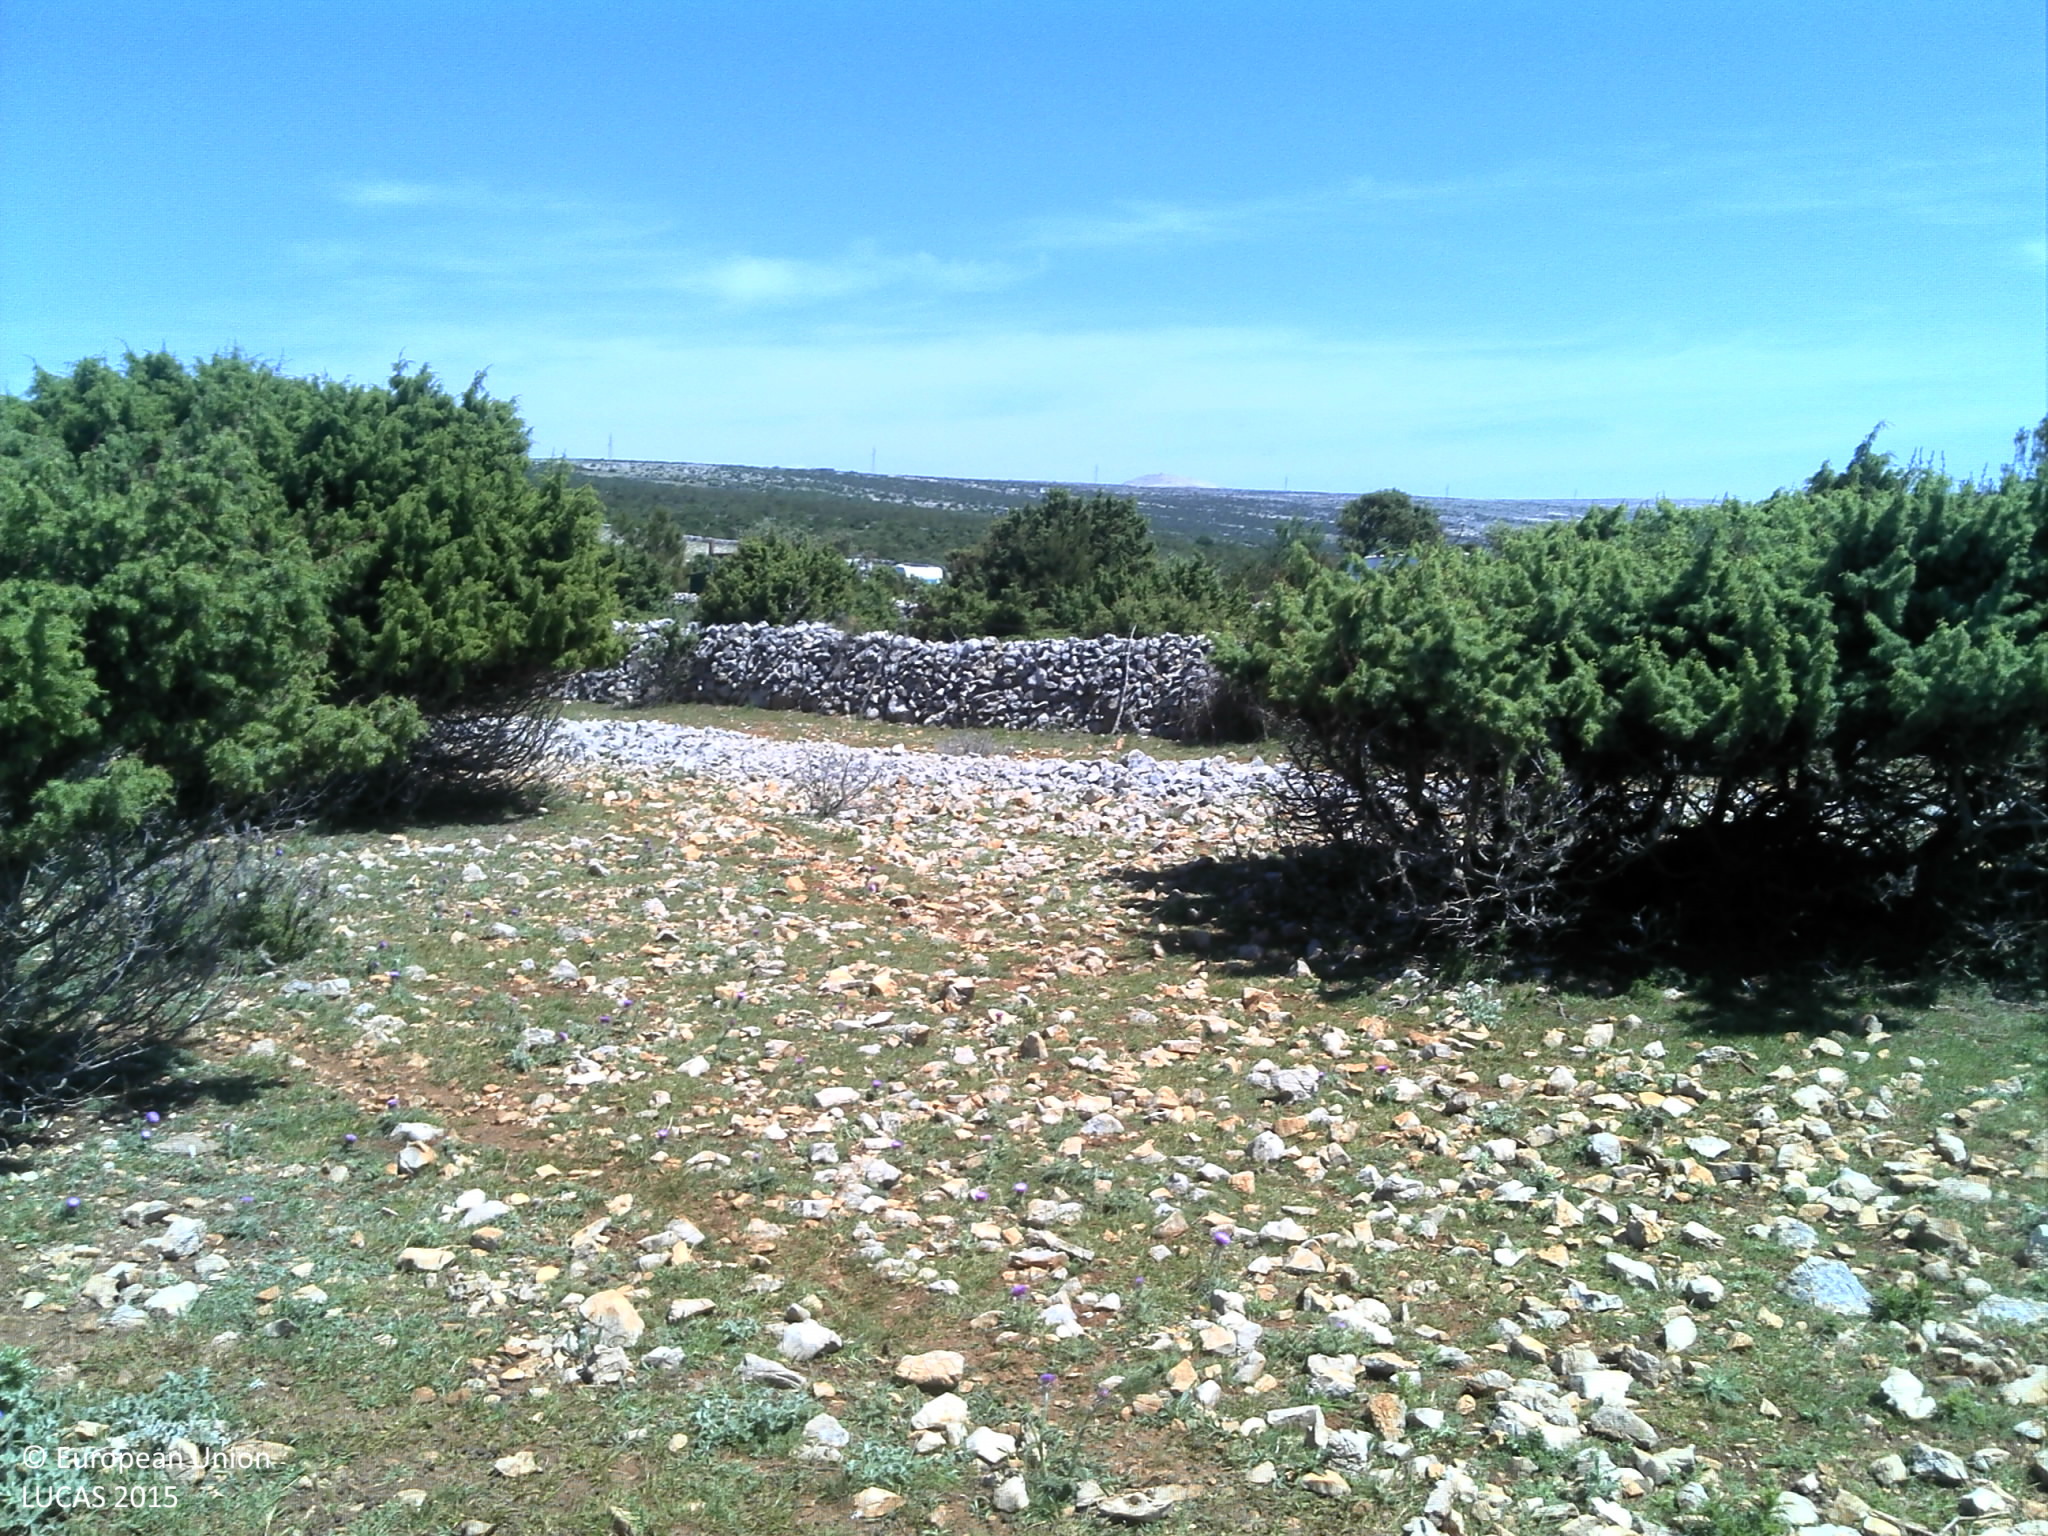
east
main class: Shrubland
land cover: Shrubland without tree cover
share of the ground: 25 - 50 %
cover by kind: unconsolidated bare surface 45 %, herbaceous plants 30 %, shrubs 25 %
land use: Agriculture (excluding fallow land and kitchen gardens)
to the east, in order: Shrubland without tree cover; Dry stone walls; Shrubland without tree cover; Dry stone walls; Artificial constructions in urban areas; Shrubland without tree cover; Tracks; Dry stone walls; Shrubland without tree cover; Dry stone walls; Grass margins; Paved roads, cycling and walking lanes; Grass margins; Dry stone walls; Rocks and stones; Shrubland without tree cover
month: May
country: HR
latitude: 44.4861
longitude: 14.9345
